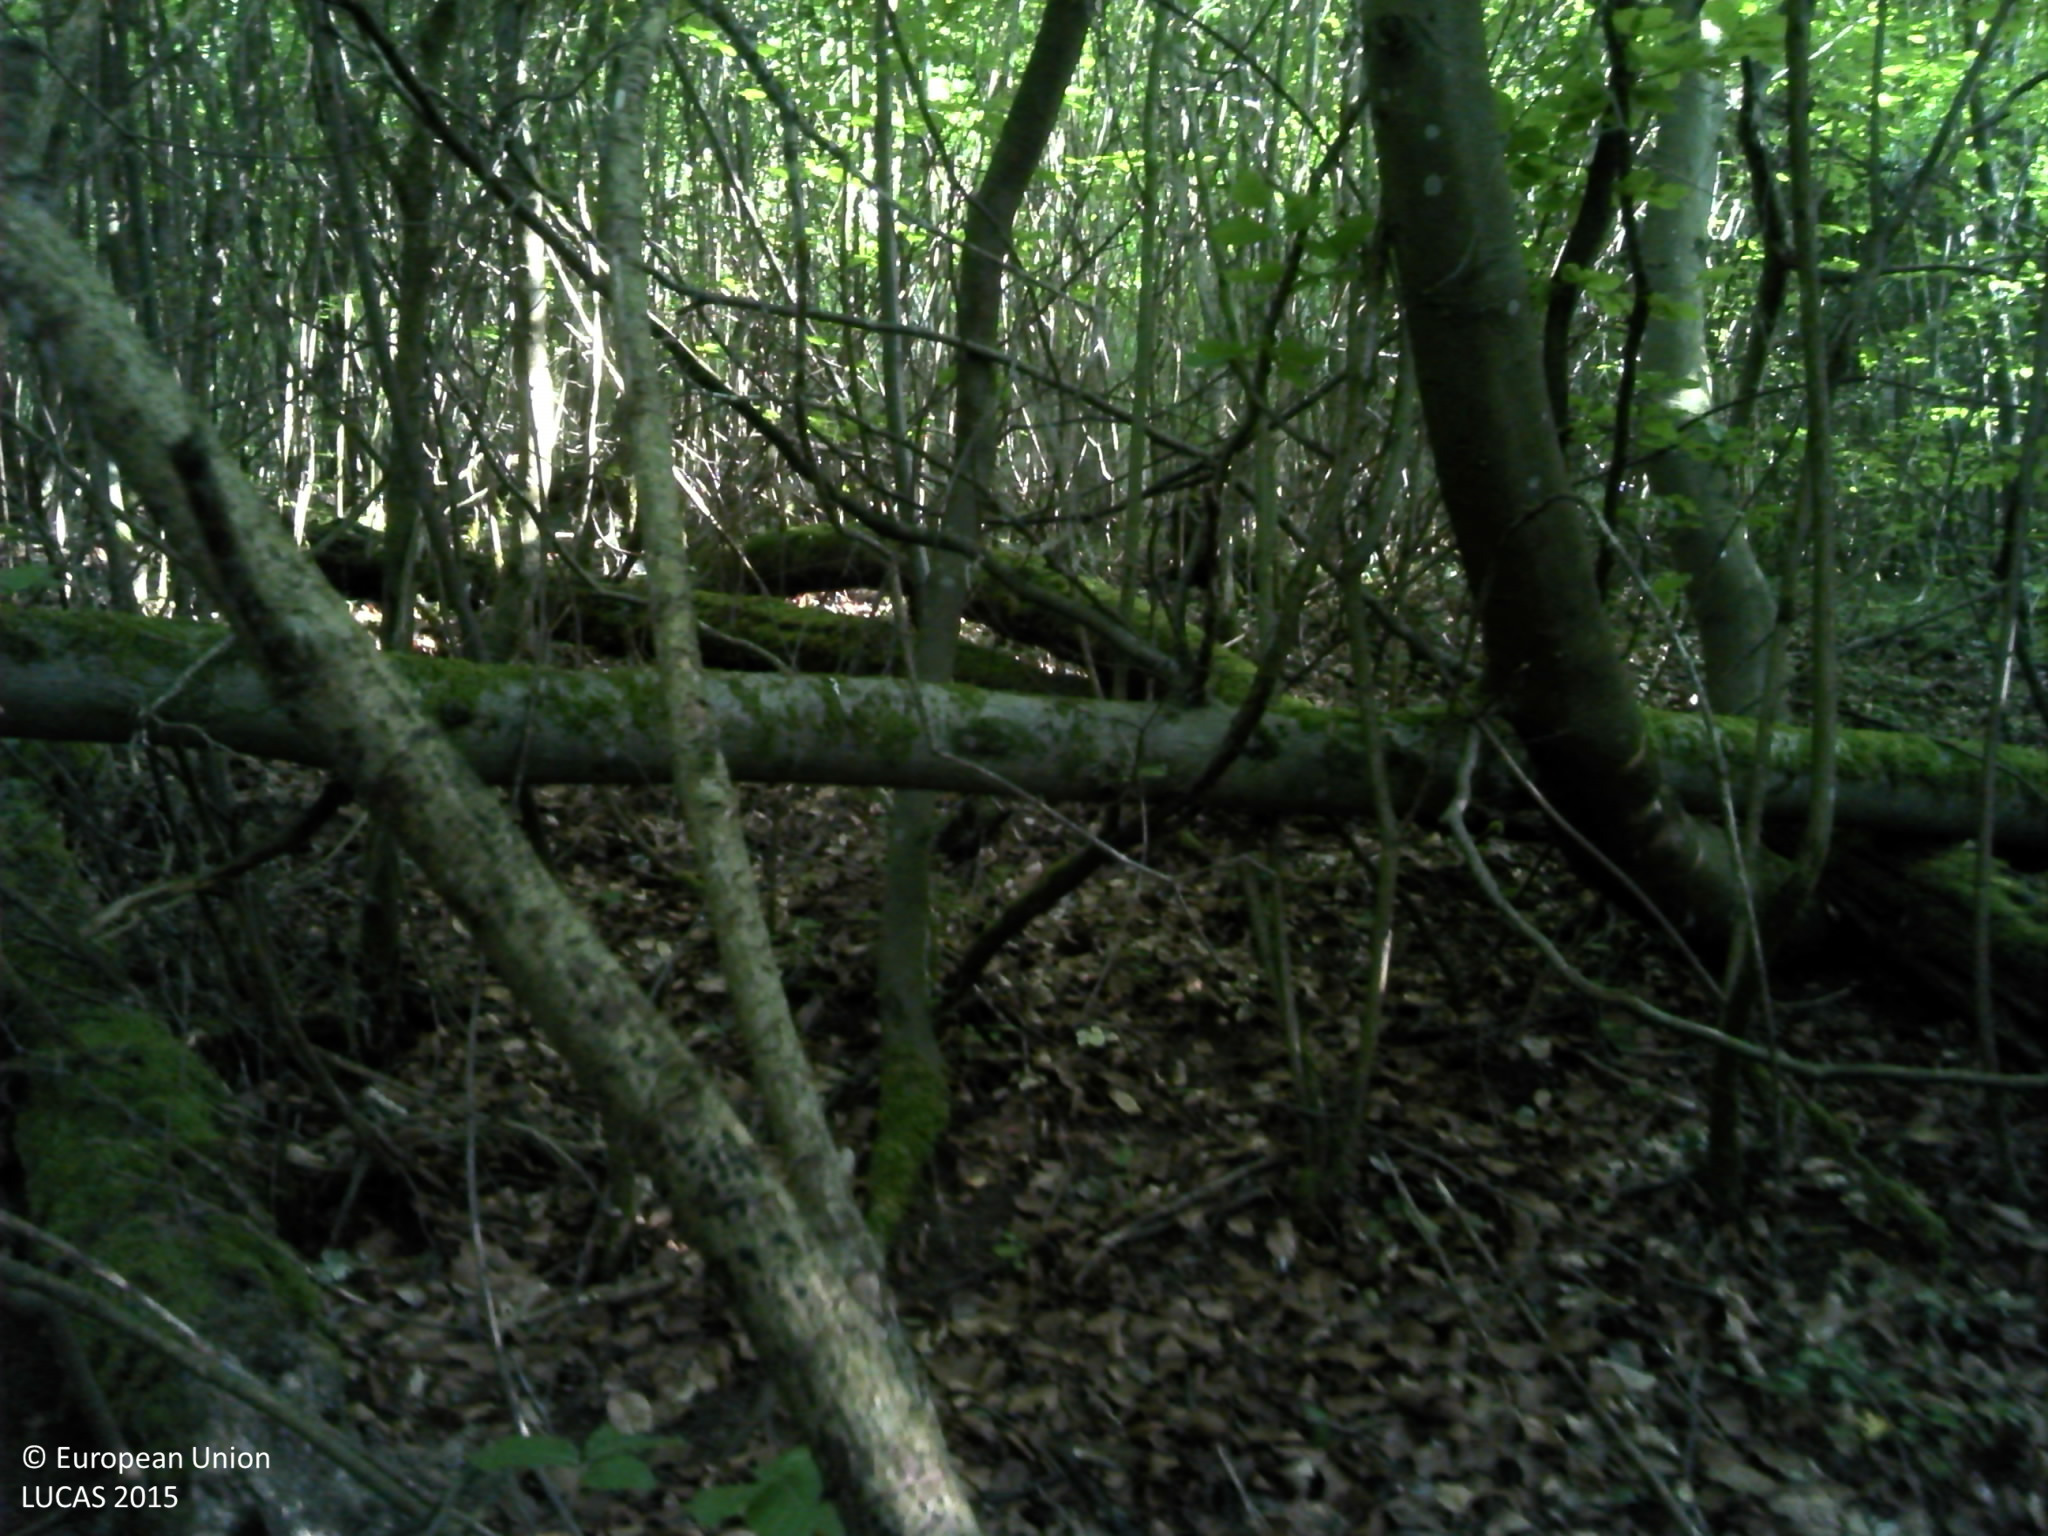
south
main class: Woodland
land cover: Broadleaved woodland
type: beech forest
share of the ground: > 75 %
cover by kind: broadleaved forest trees 100 %
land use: Forestry
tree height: > 5 m
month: June
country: FR
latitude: 49.2168
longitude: 6.0869
